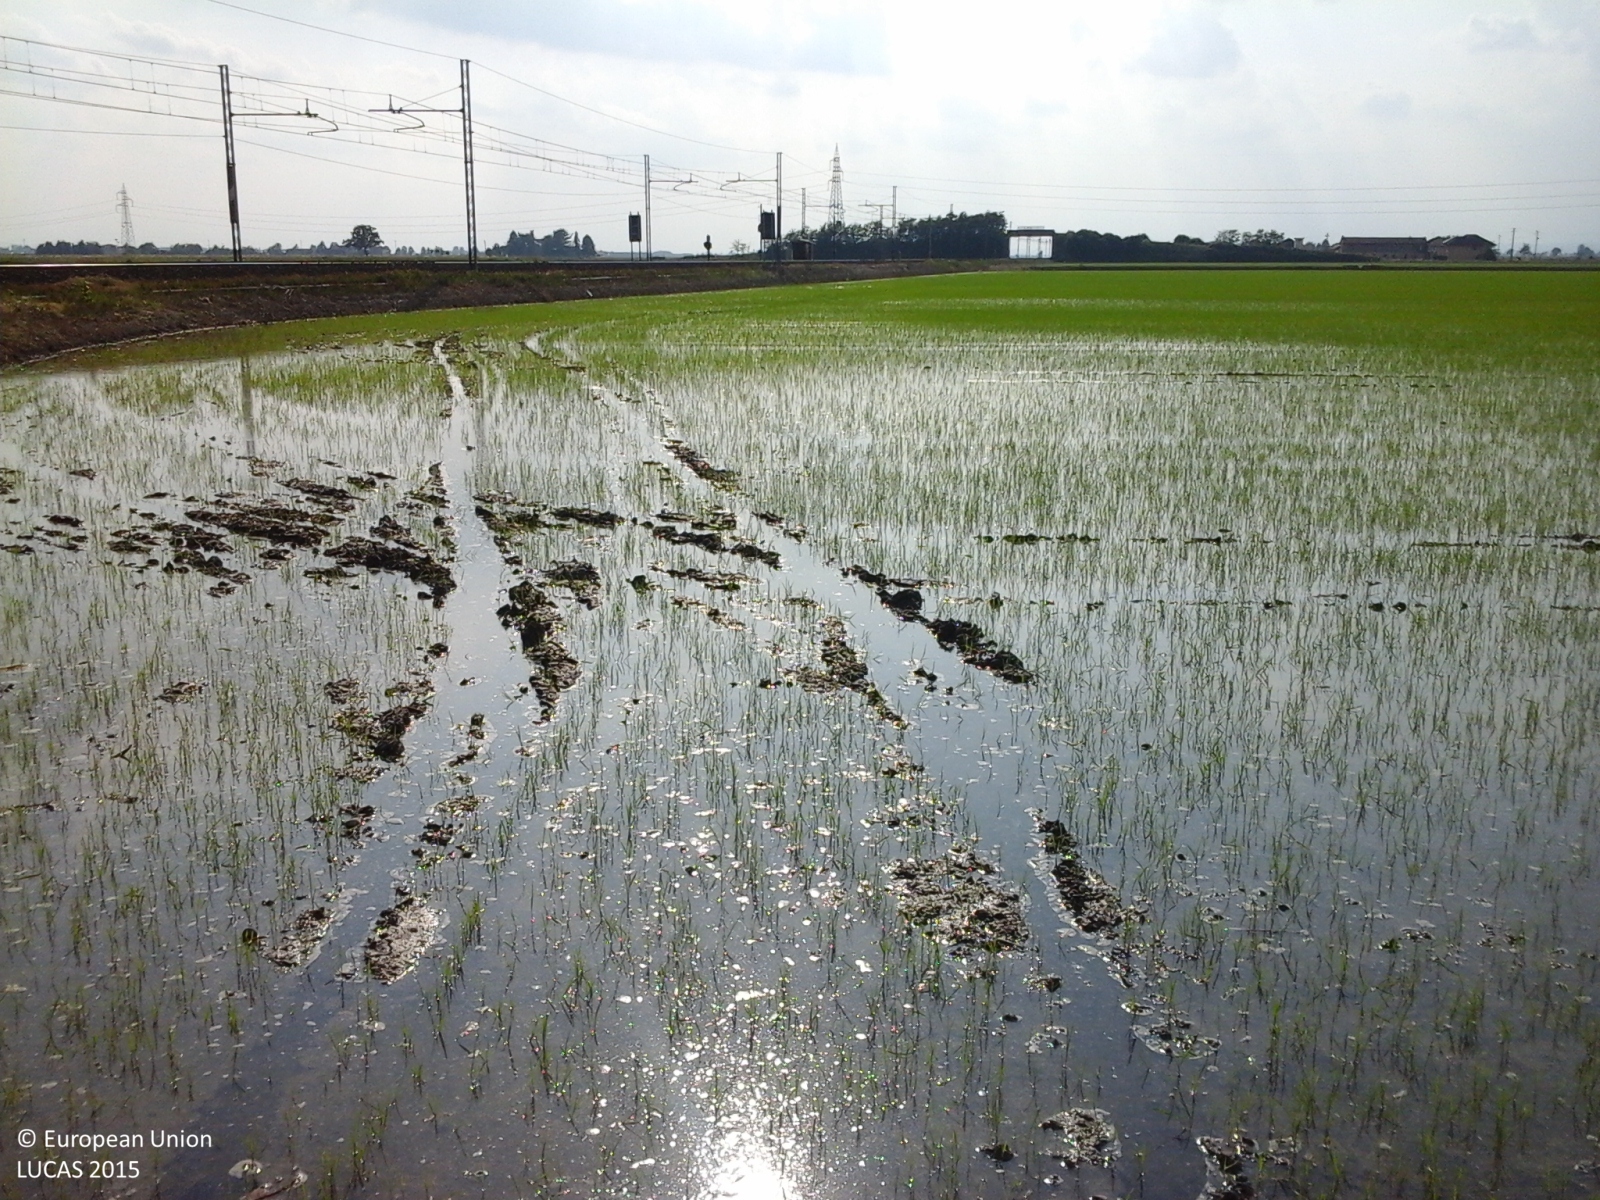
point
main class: Cropland
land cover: Rice
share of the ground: 25 - 50 %
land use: Agriculture (excluding fallow land and kitchen gardens)
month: May
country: IT
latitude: 45.3298
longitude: 8.3824
